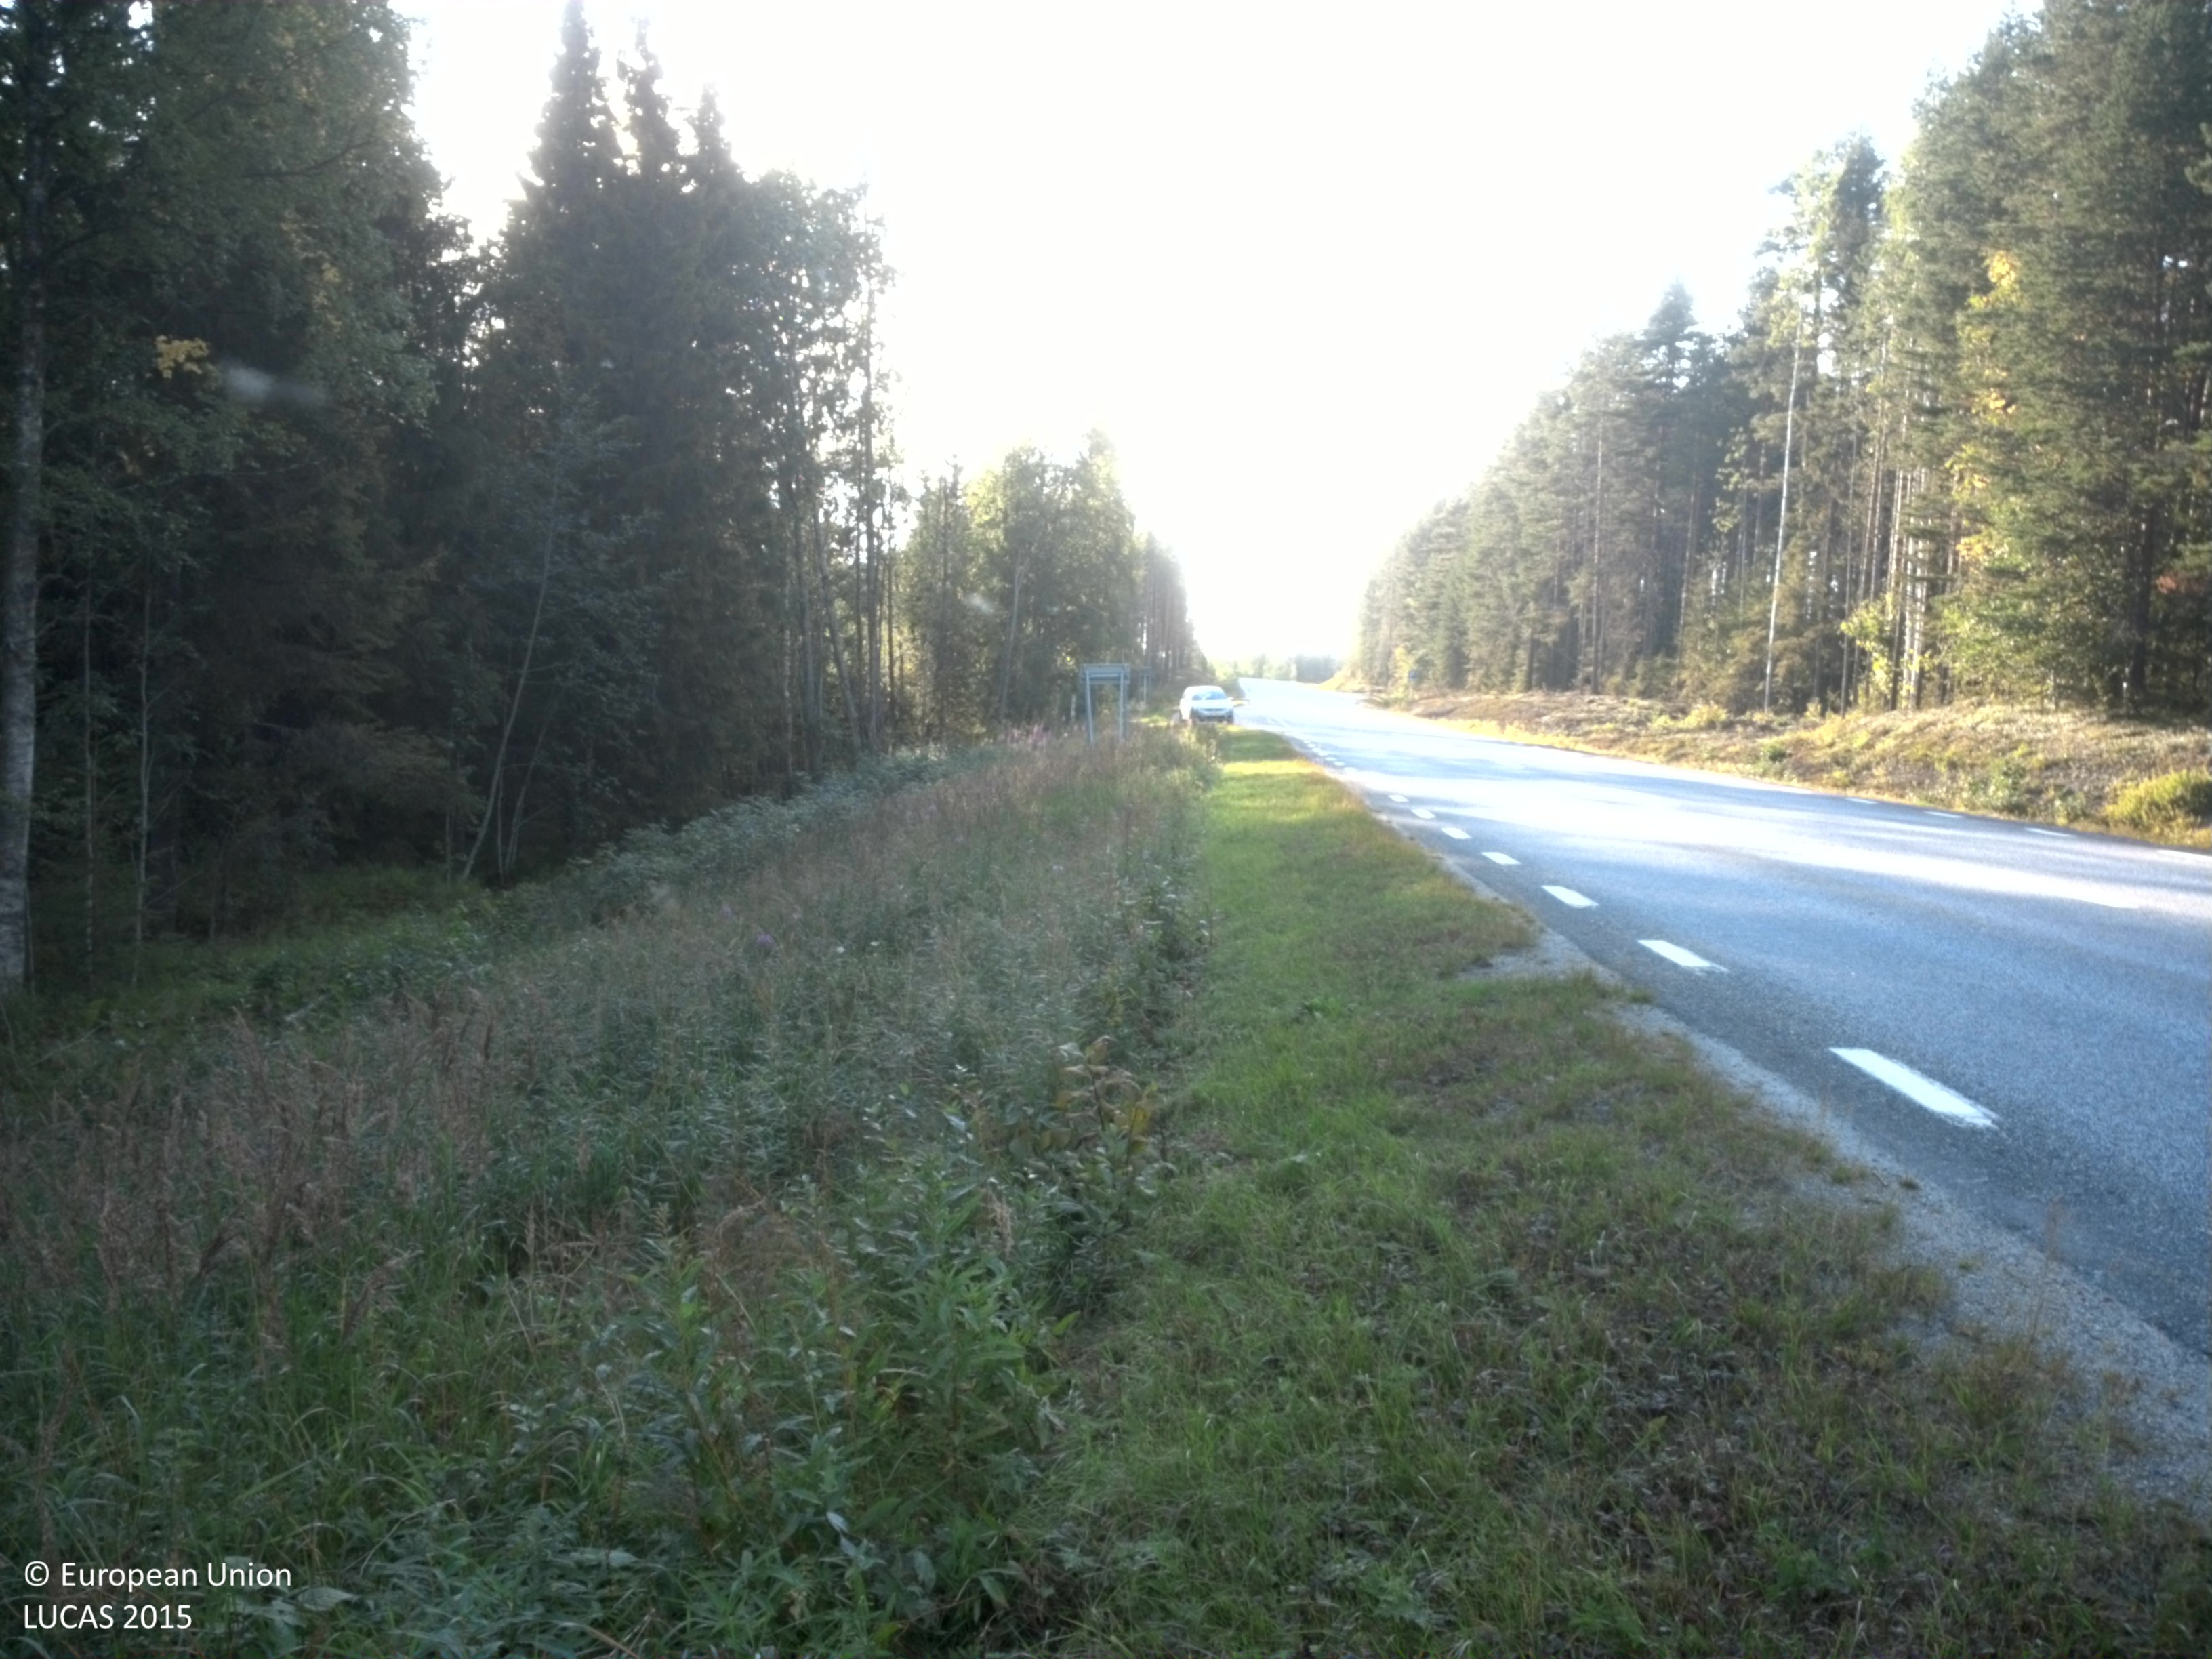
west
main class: Grassland
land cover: Grassland without tree/shrub cover
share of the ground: > 75 %
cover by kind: herbaceous plants 100 %
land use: Road transport
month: August
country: SE
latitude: 64.5139
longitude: 18.8632
